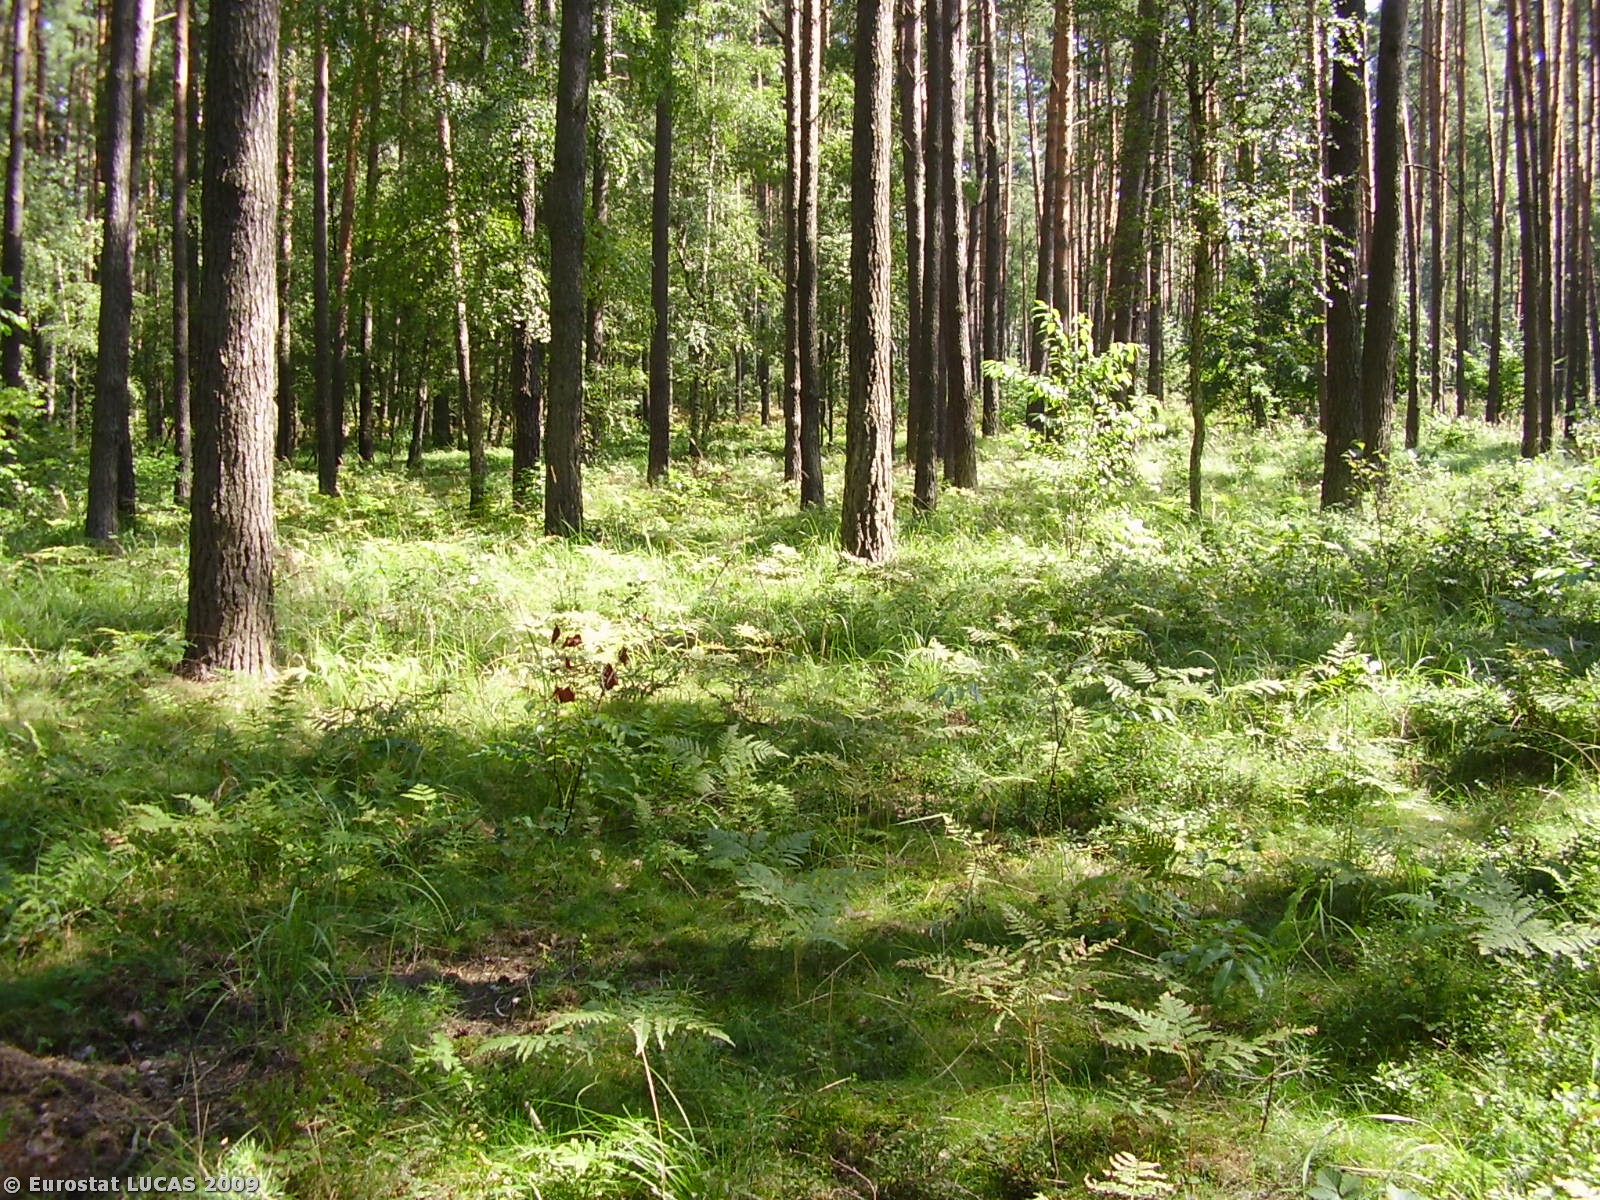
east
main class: Woodland
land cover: Mixed woodland
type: hemiboreal forest and nemoral coniferous forest and mixed broadleaved-coniferous forest
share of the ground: > 75 %
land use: Forestry
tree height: > 5 m
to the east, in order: Mixed woodland; Tracks; Mixed woodland
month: August
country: PL
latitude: 51.3369
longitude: 16.1068
